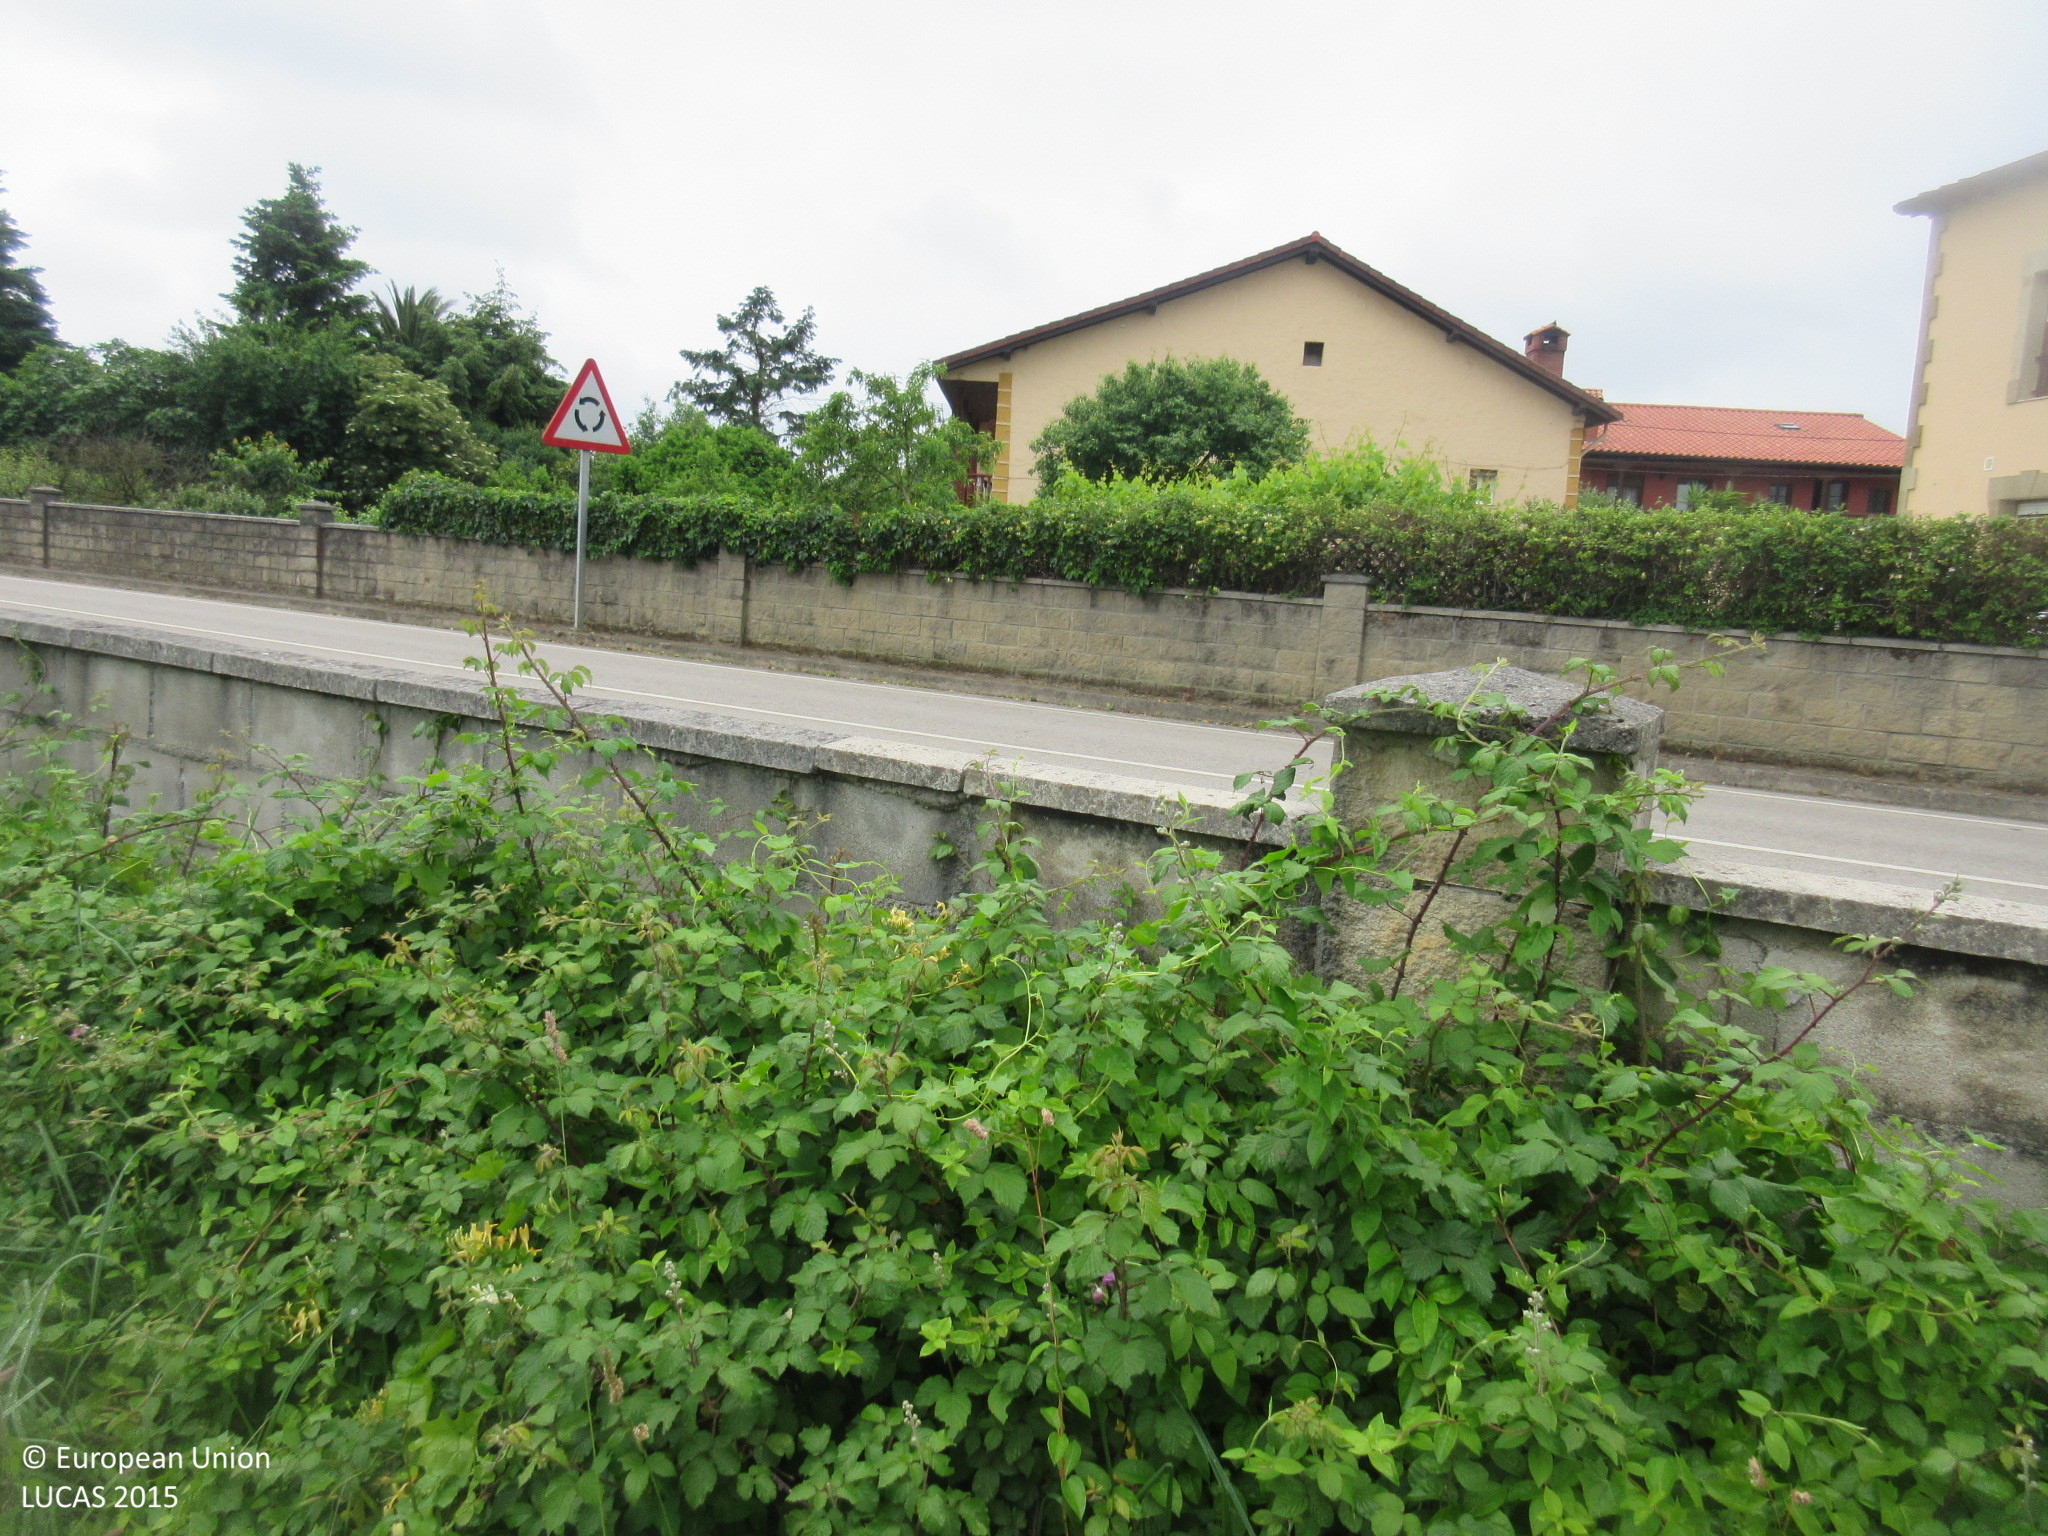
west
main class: Grassland
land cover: Grassland without tree/shrub cover
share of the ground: > 75 %
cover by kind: herbaceous plants 100 %
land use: Agriculture (excluding fallow land and kitchen gardens)
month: June
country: ES
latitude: 43.4567
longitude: -3.5531
